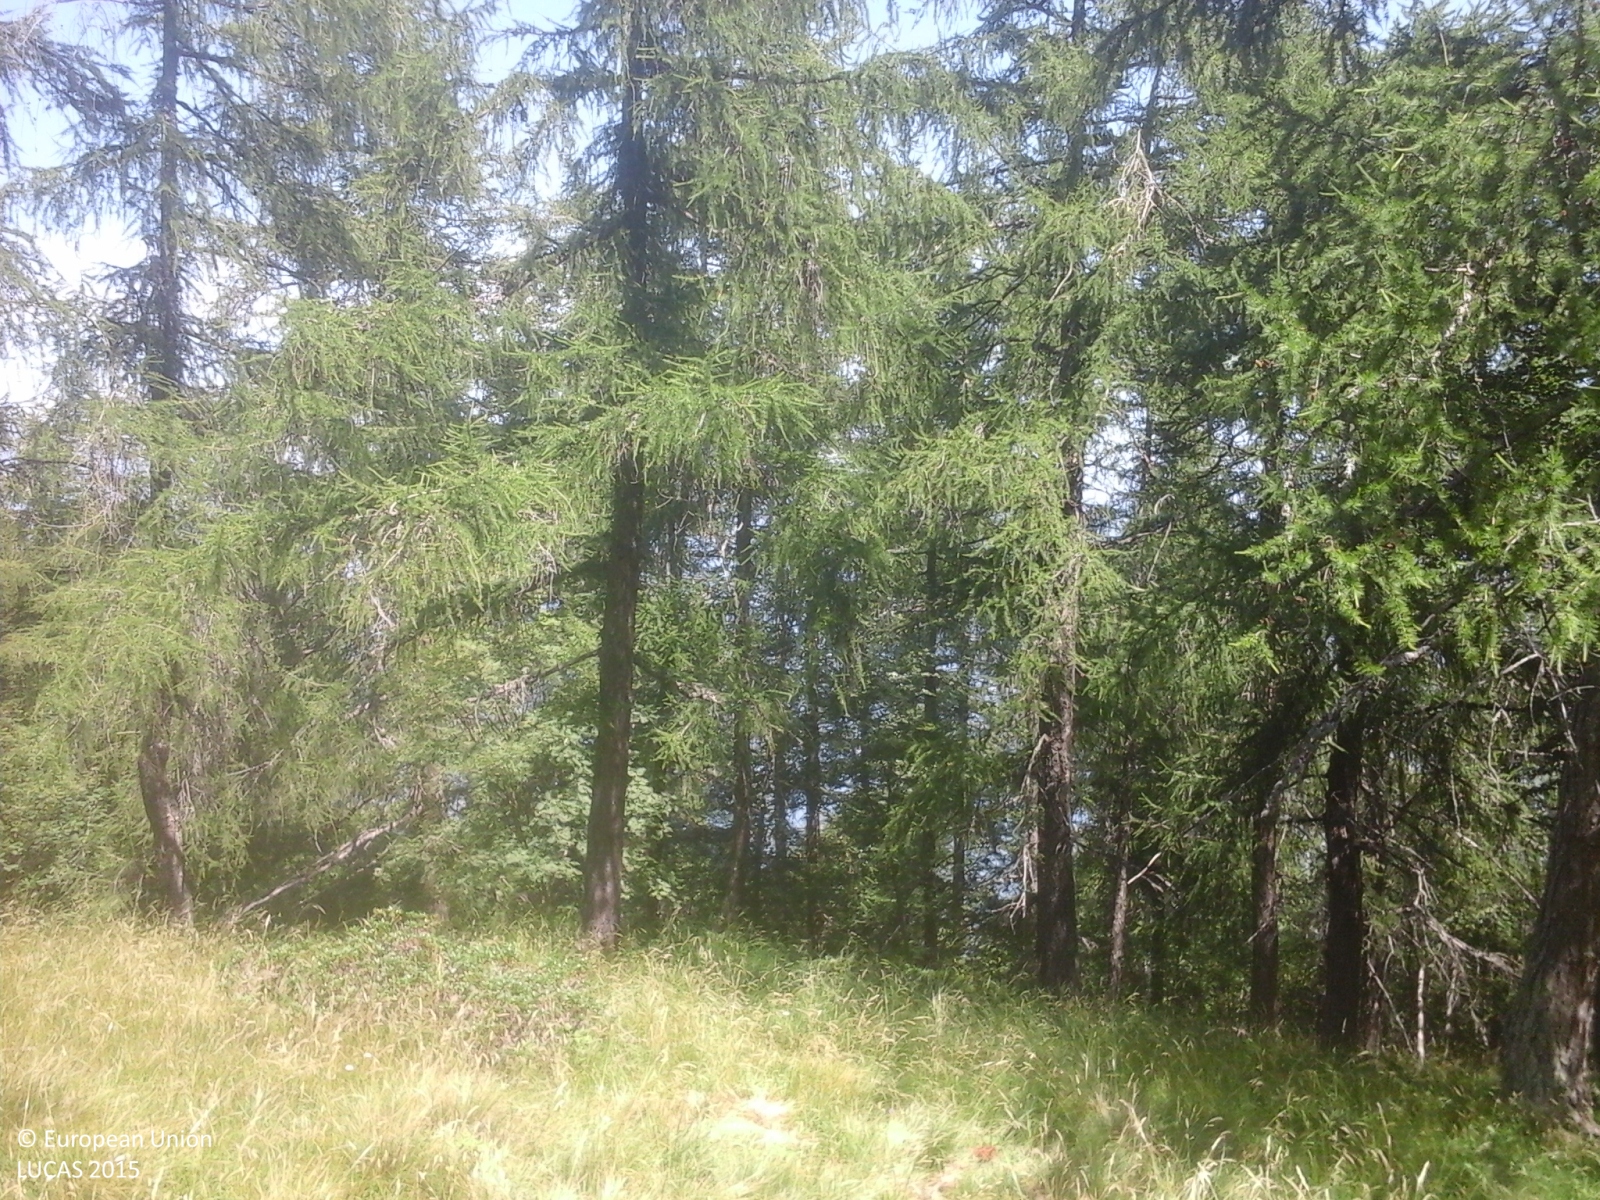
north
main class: Woodland
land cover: Spruce dominated mixed woodland
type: alpine coniferous forest
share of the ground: > 75 %
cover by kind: coniferous forest trees 65 %, broadleaved forest trees 25 %, herbaceous plants 10 %
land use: Forestry
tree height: > 5 m
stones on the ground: < 10 %
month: July
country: IT
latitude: 46.0971
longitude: 9.3671
